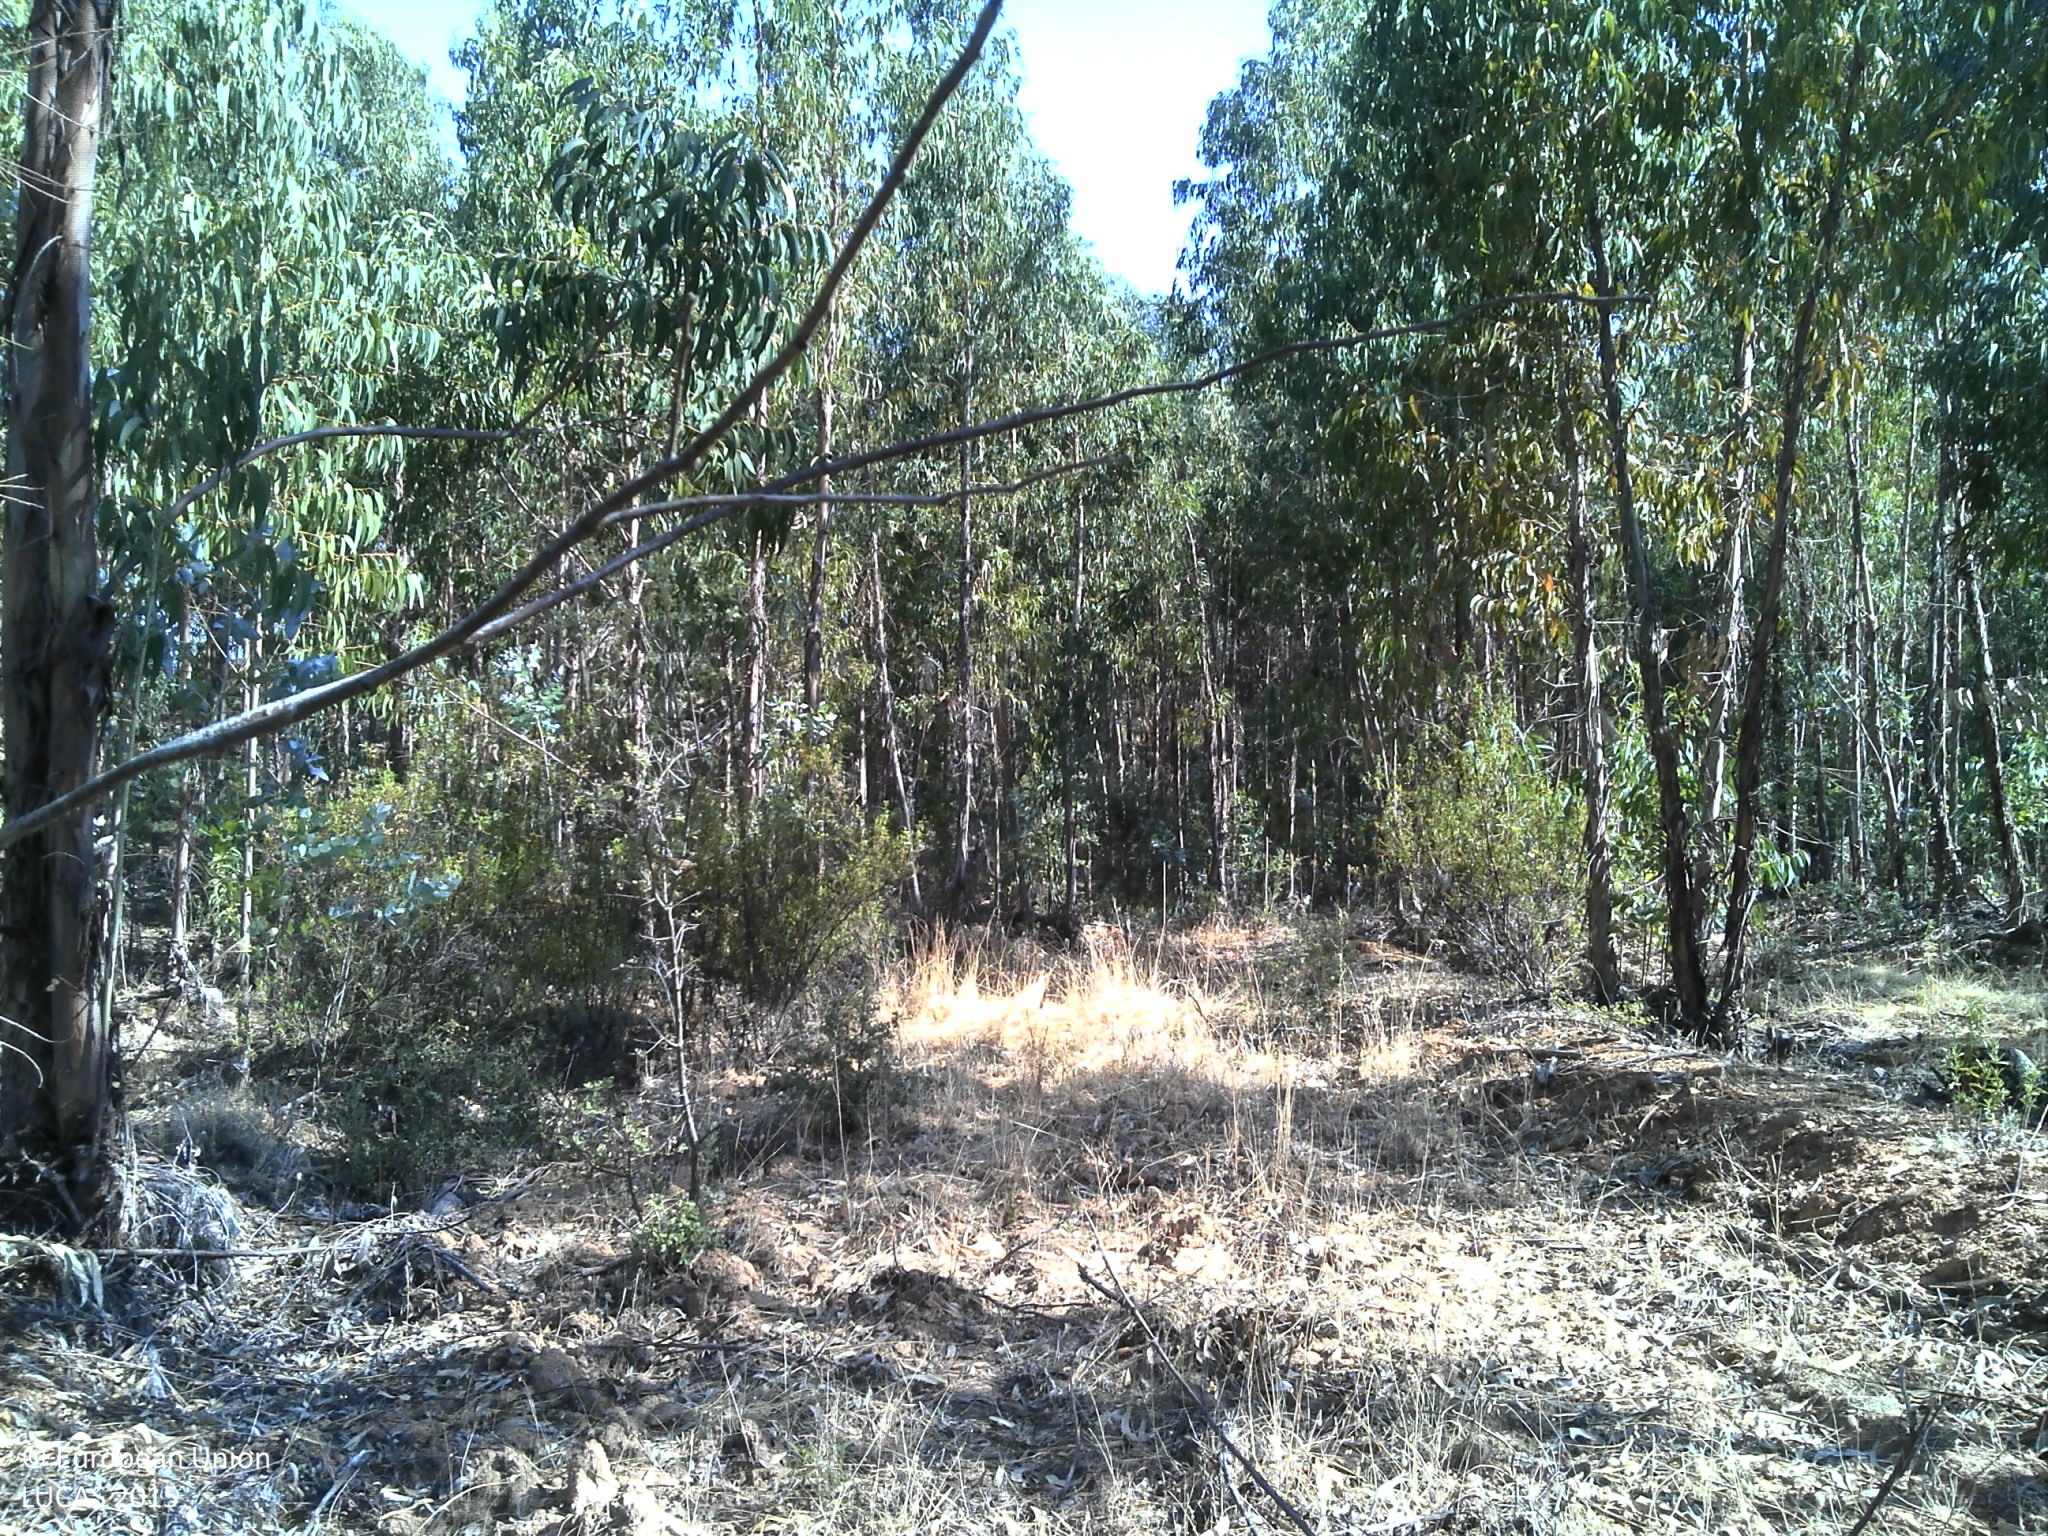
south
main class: Woodland
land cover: Broadleaved woodland
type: exotic forest
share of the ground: 50 - 75 %
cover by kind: broadleaved forest trees 75 %, shrubs 15 %, unconsolidated bare surface 10 %
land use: Forestry
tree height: > 5 m
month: July
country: PT
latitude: 38.7346
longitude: -7.5074
